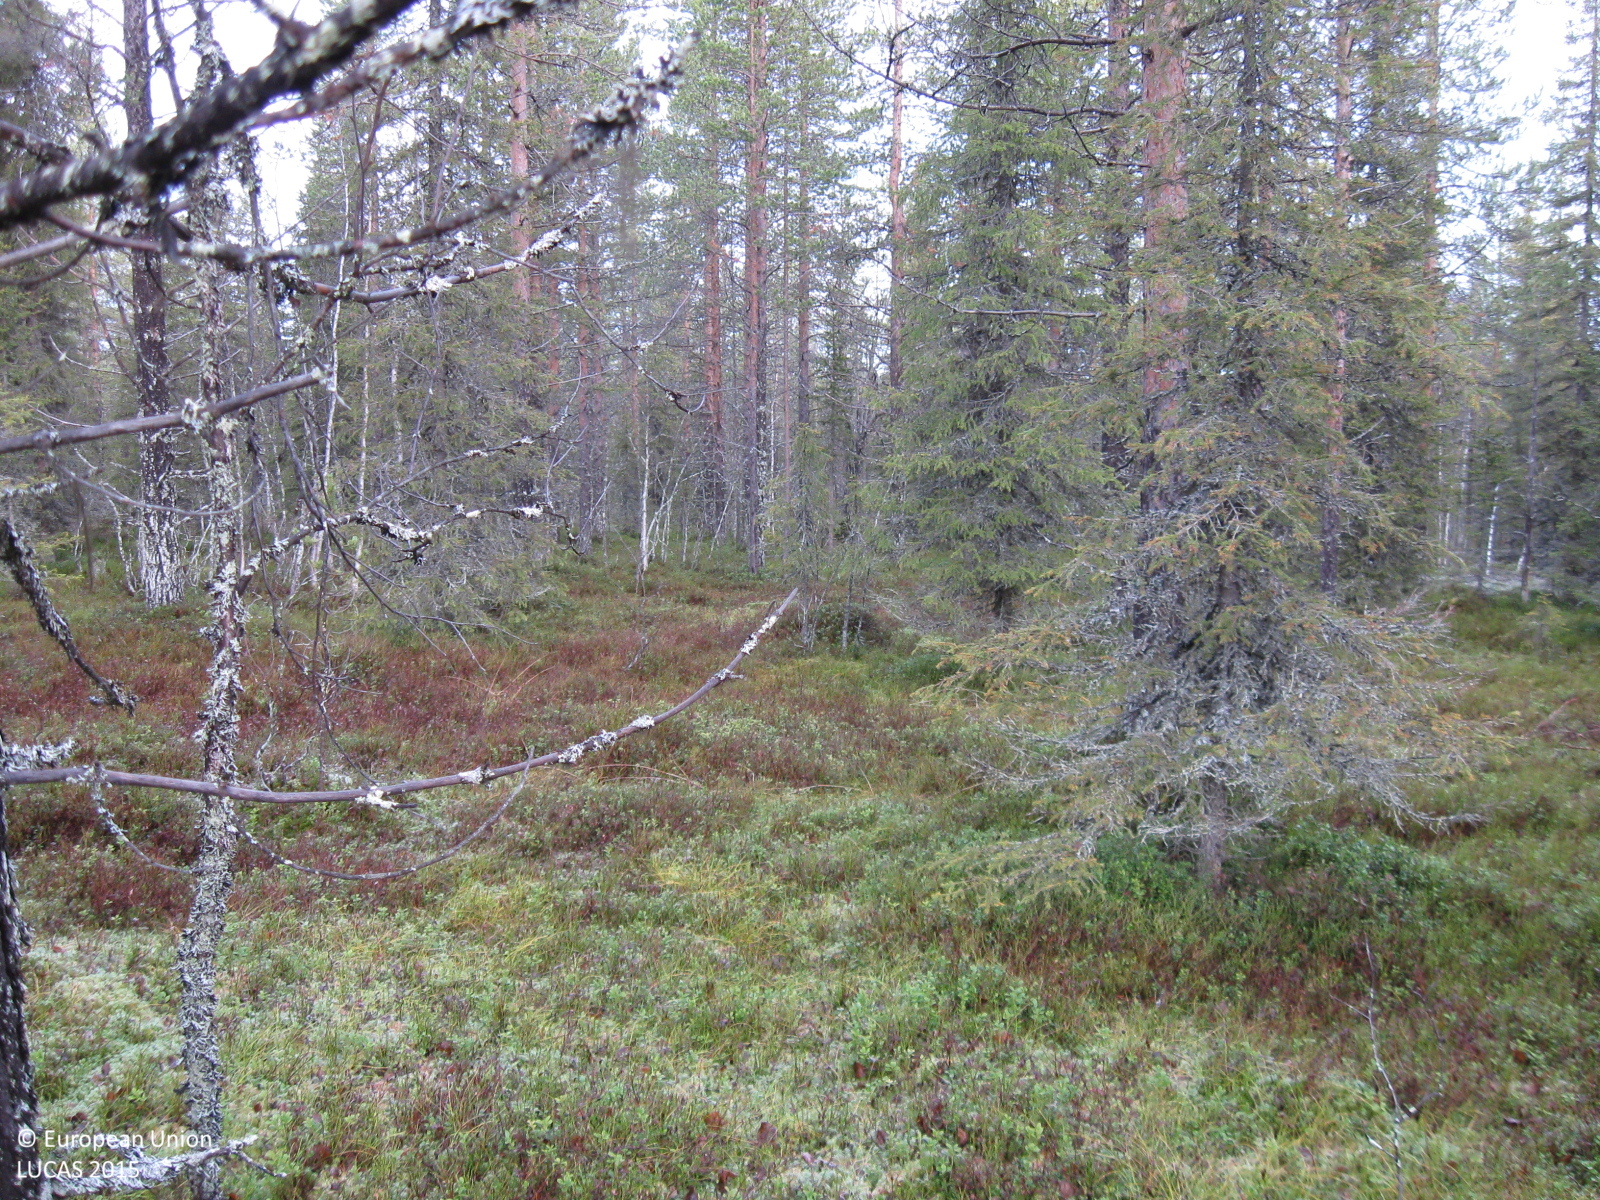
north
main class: Woodland
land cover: Pine dominated coniferous woodland
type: boreal forest
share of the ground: 50 - 75 %
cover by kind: coniferous forest trees 60 %, shrubs 15 %, broadleaved forest trees 10 %, lichens and mosses 10 %, herbaceous plants 5 %
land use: Forestry
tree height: > 5 m
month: October
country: SE
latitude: 66.5238
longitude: 21.5024
